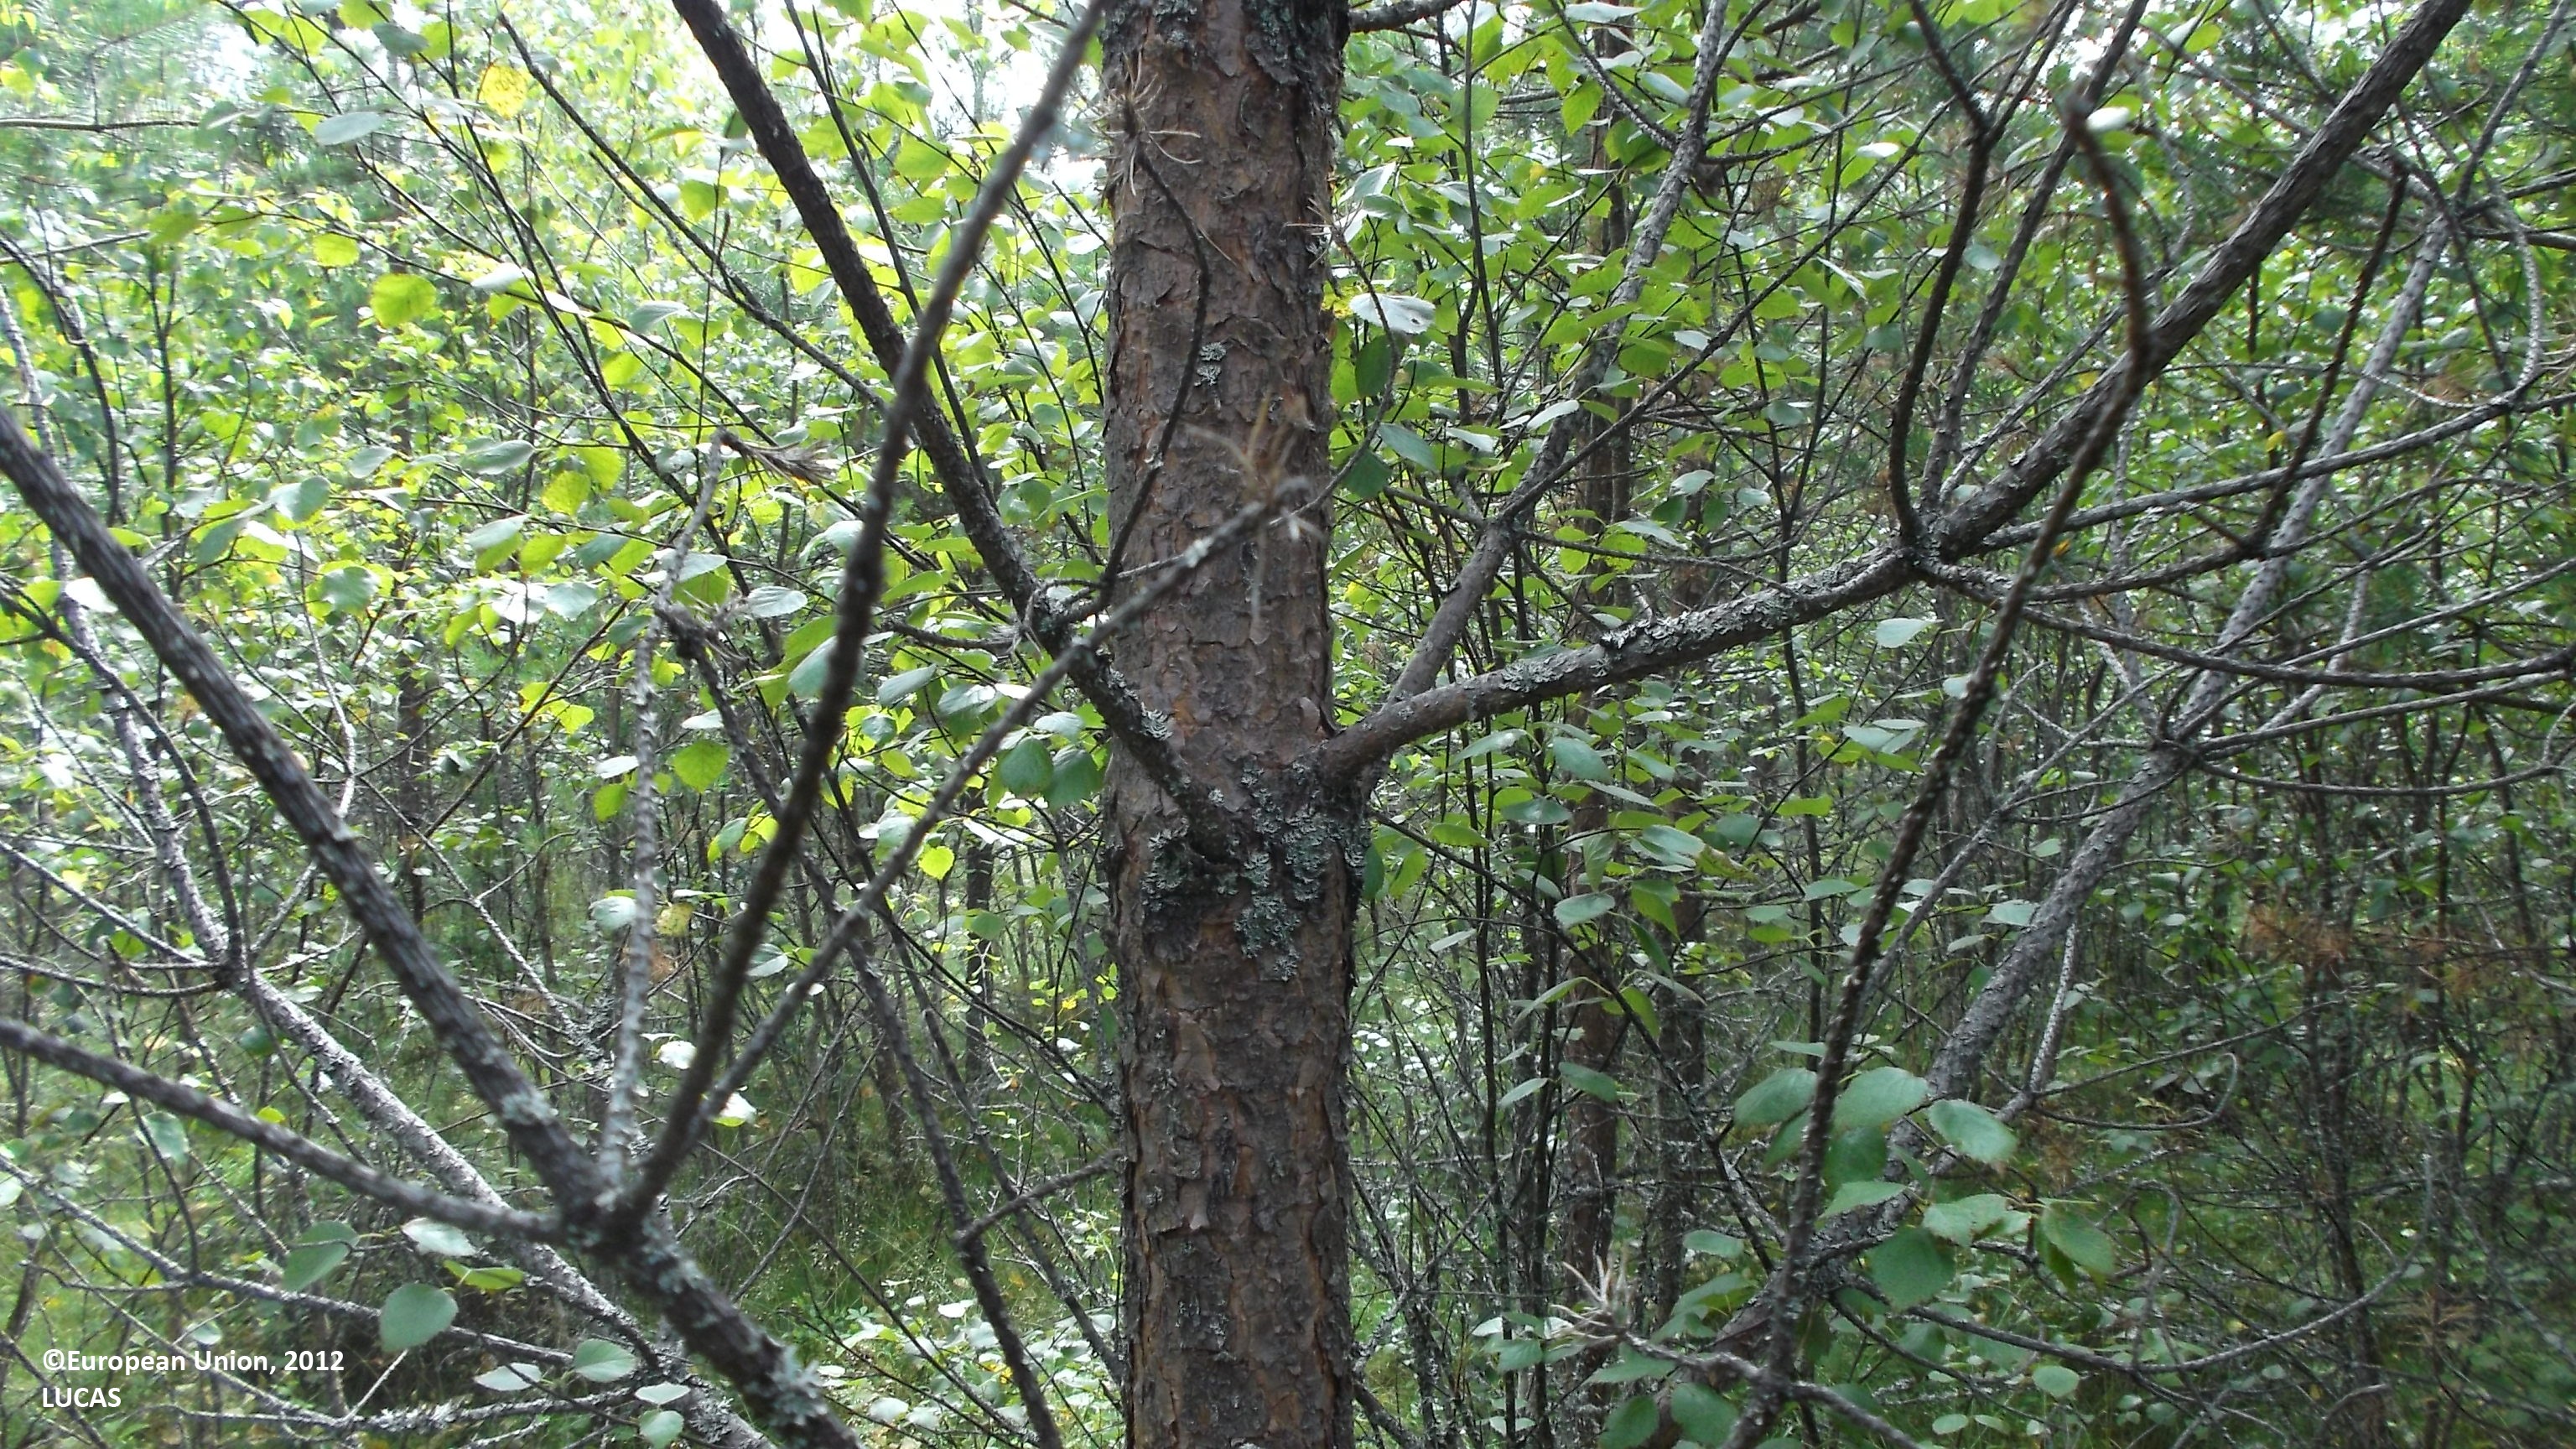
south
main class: Woodland
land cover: Other mixed woodland
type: boreal forest
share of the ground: 50 - 75 %
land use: Forestry
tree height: > 5 m
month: July
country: FI
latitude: 63.6638
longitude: 23.3725
